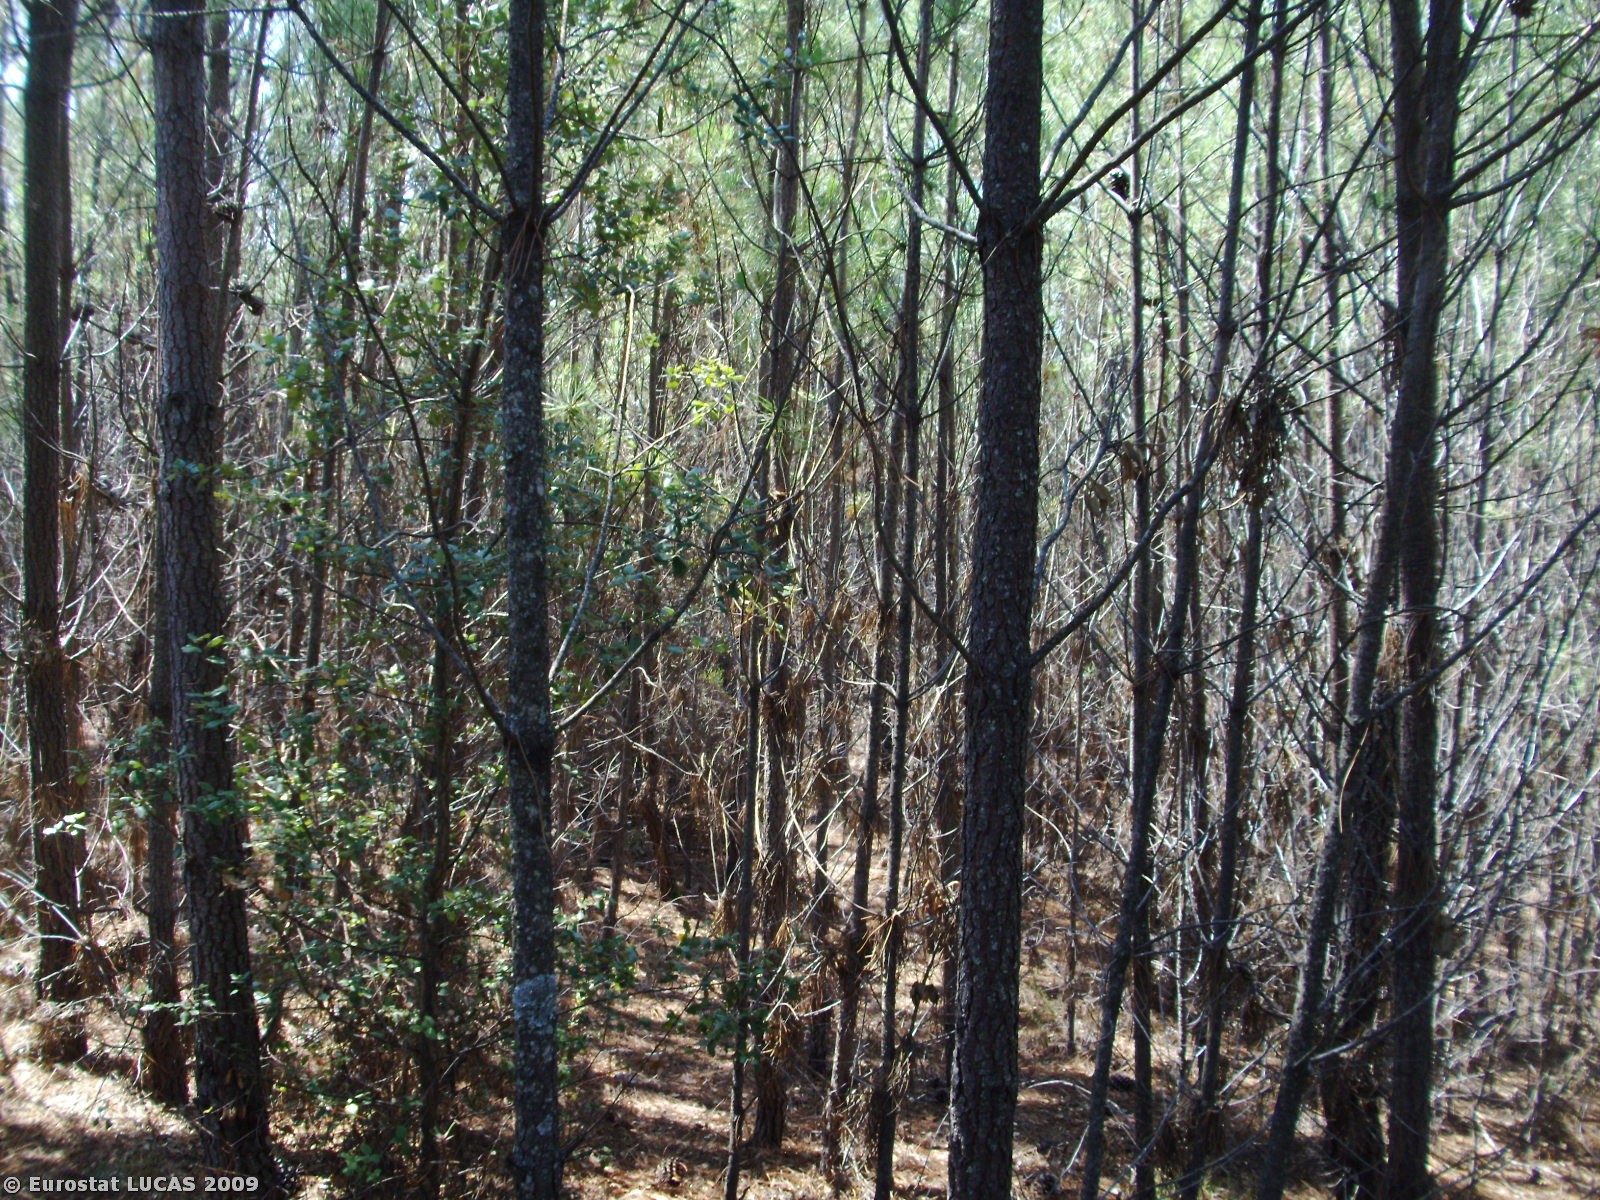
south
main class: Woodland
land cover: Coniferous woodland
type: coniferous forest of the mediterranean region
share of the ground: > 75 %
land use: Forestry
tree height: > 5 m
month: August
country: PT
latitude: 40.1946
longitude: -7.5990
